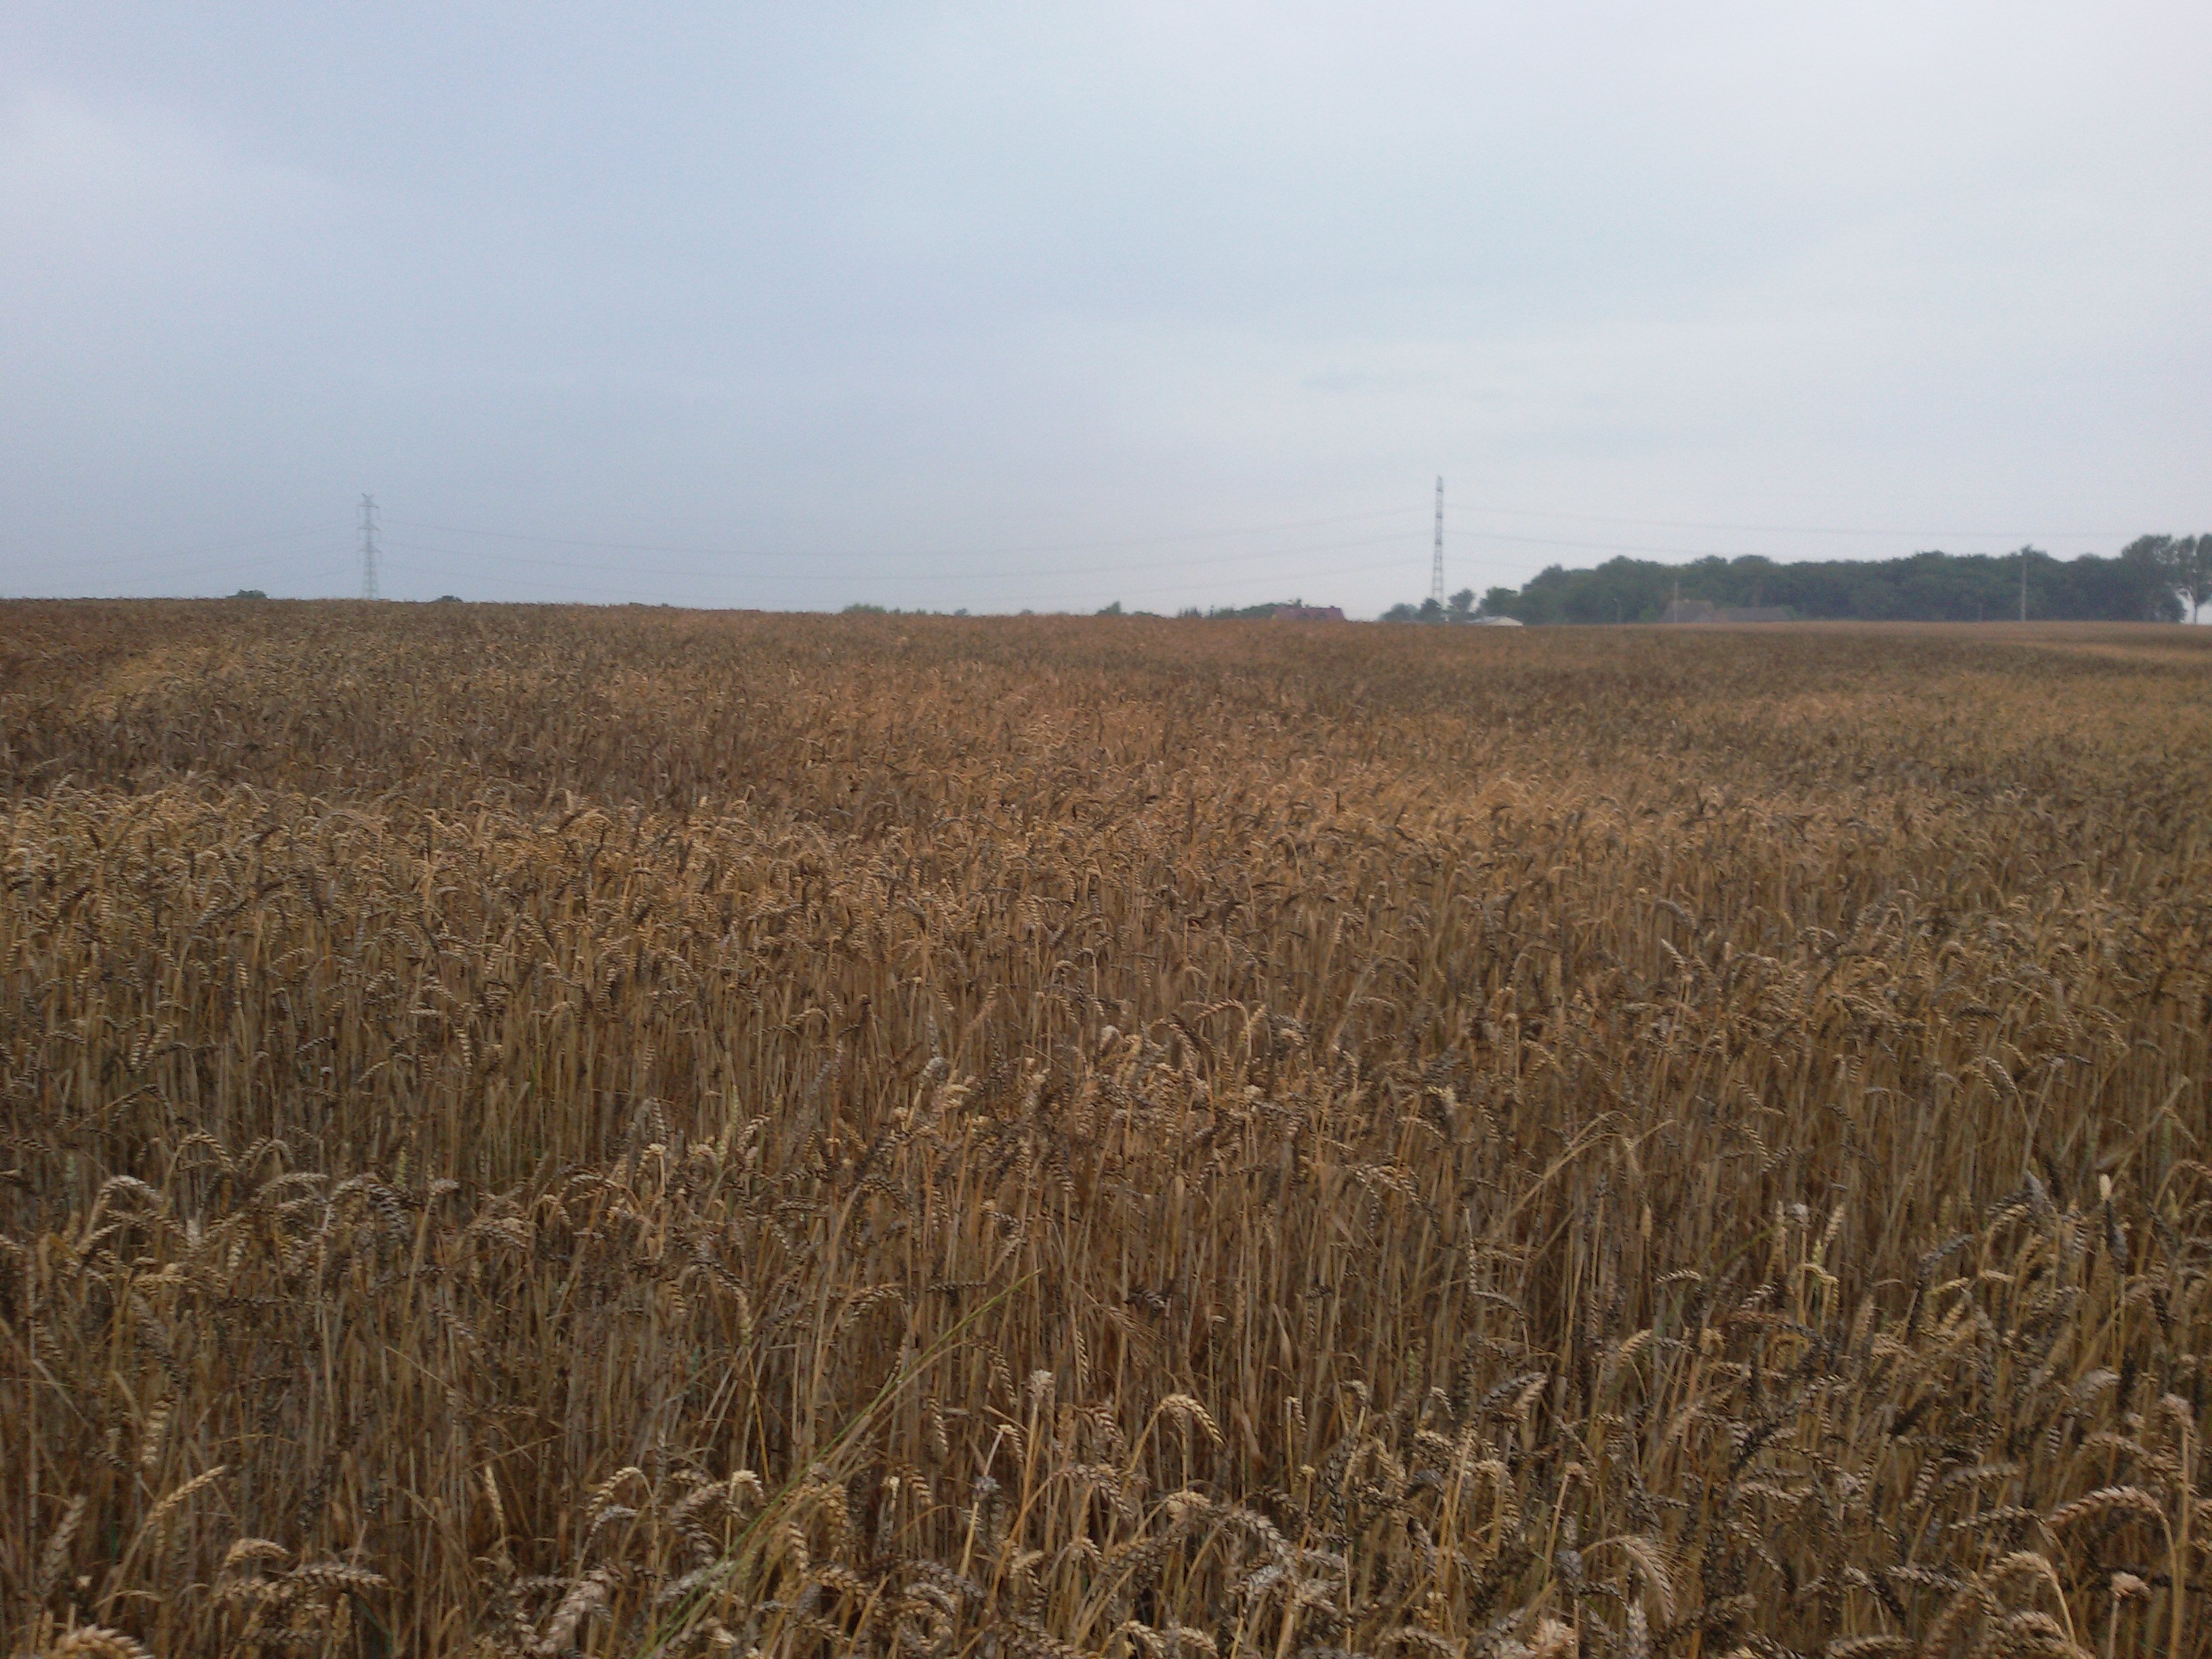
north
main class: Cropland
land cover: Common wheat
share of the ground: > 75 %
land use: Agriculture (excluding fallow land and kitchen gardens)
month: July
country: PL
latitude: 52.2843
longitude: 17.5033
